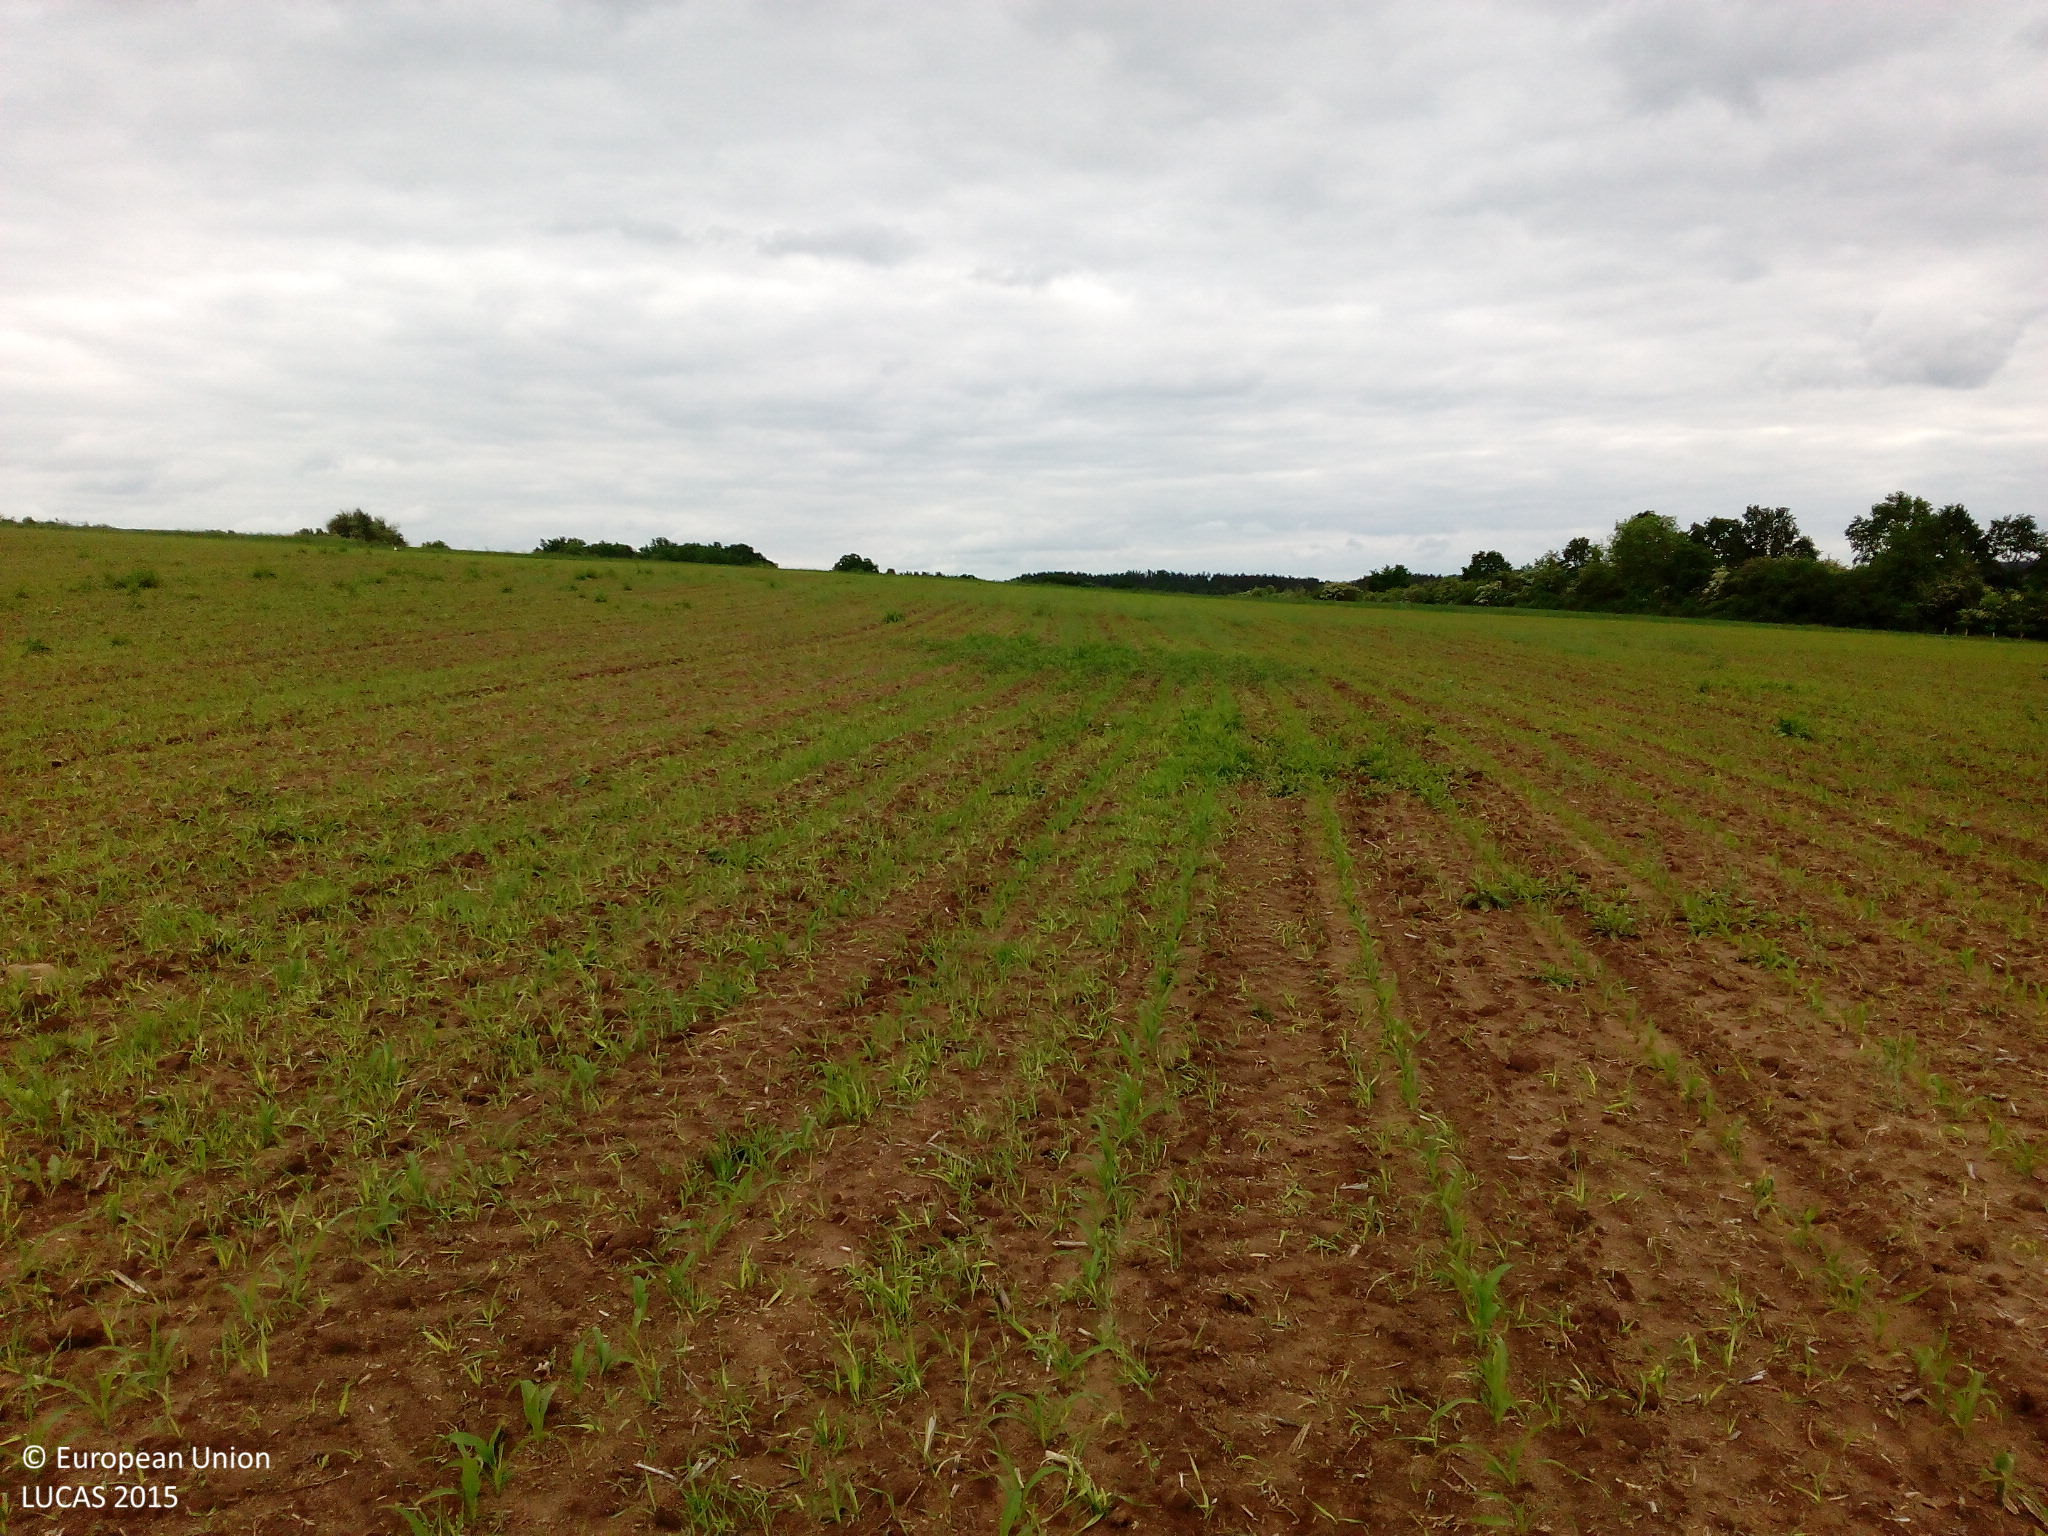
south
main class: Cropland
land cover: Maize
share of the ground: < 10 %
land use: Agriculture (excluding fallow land and kitchen gardens)
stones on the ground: < 10 %
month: May
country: DE
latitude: 49.9212
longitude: 11.6013
